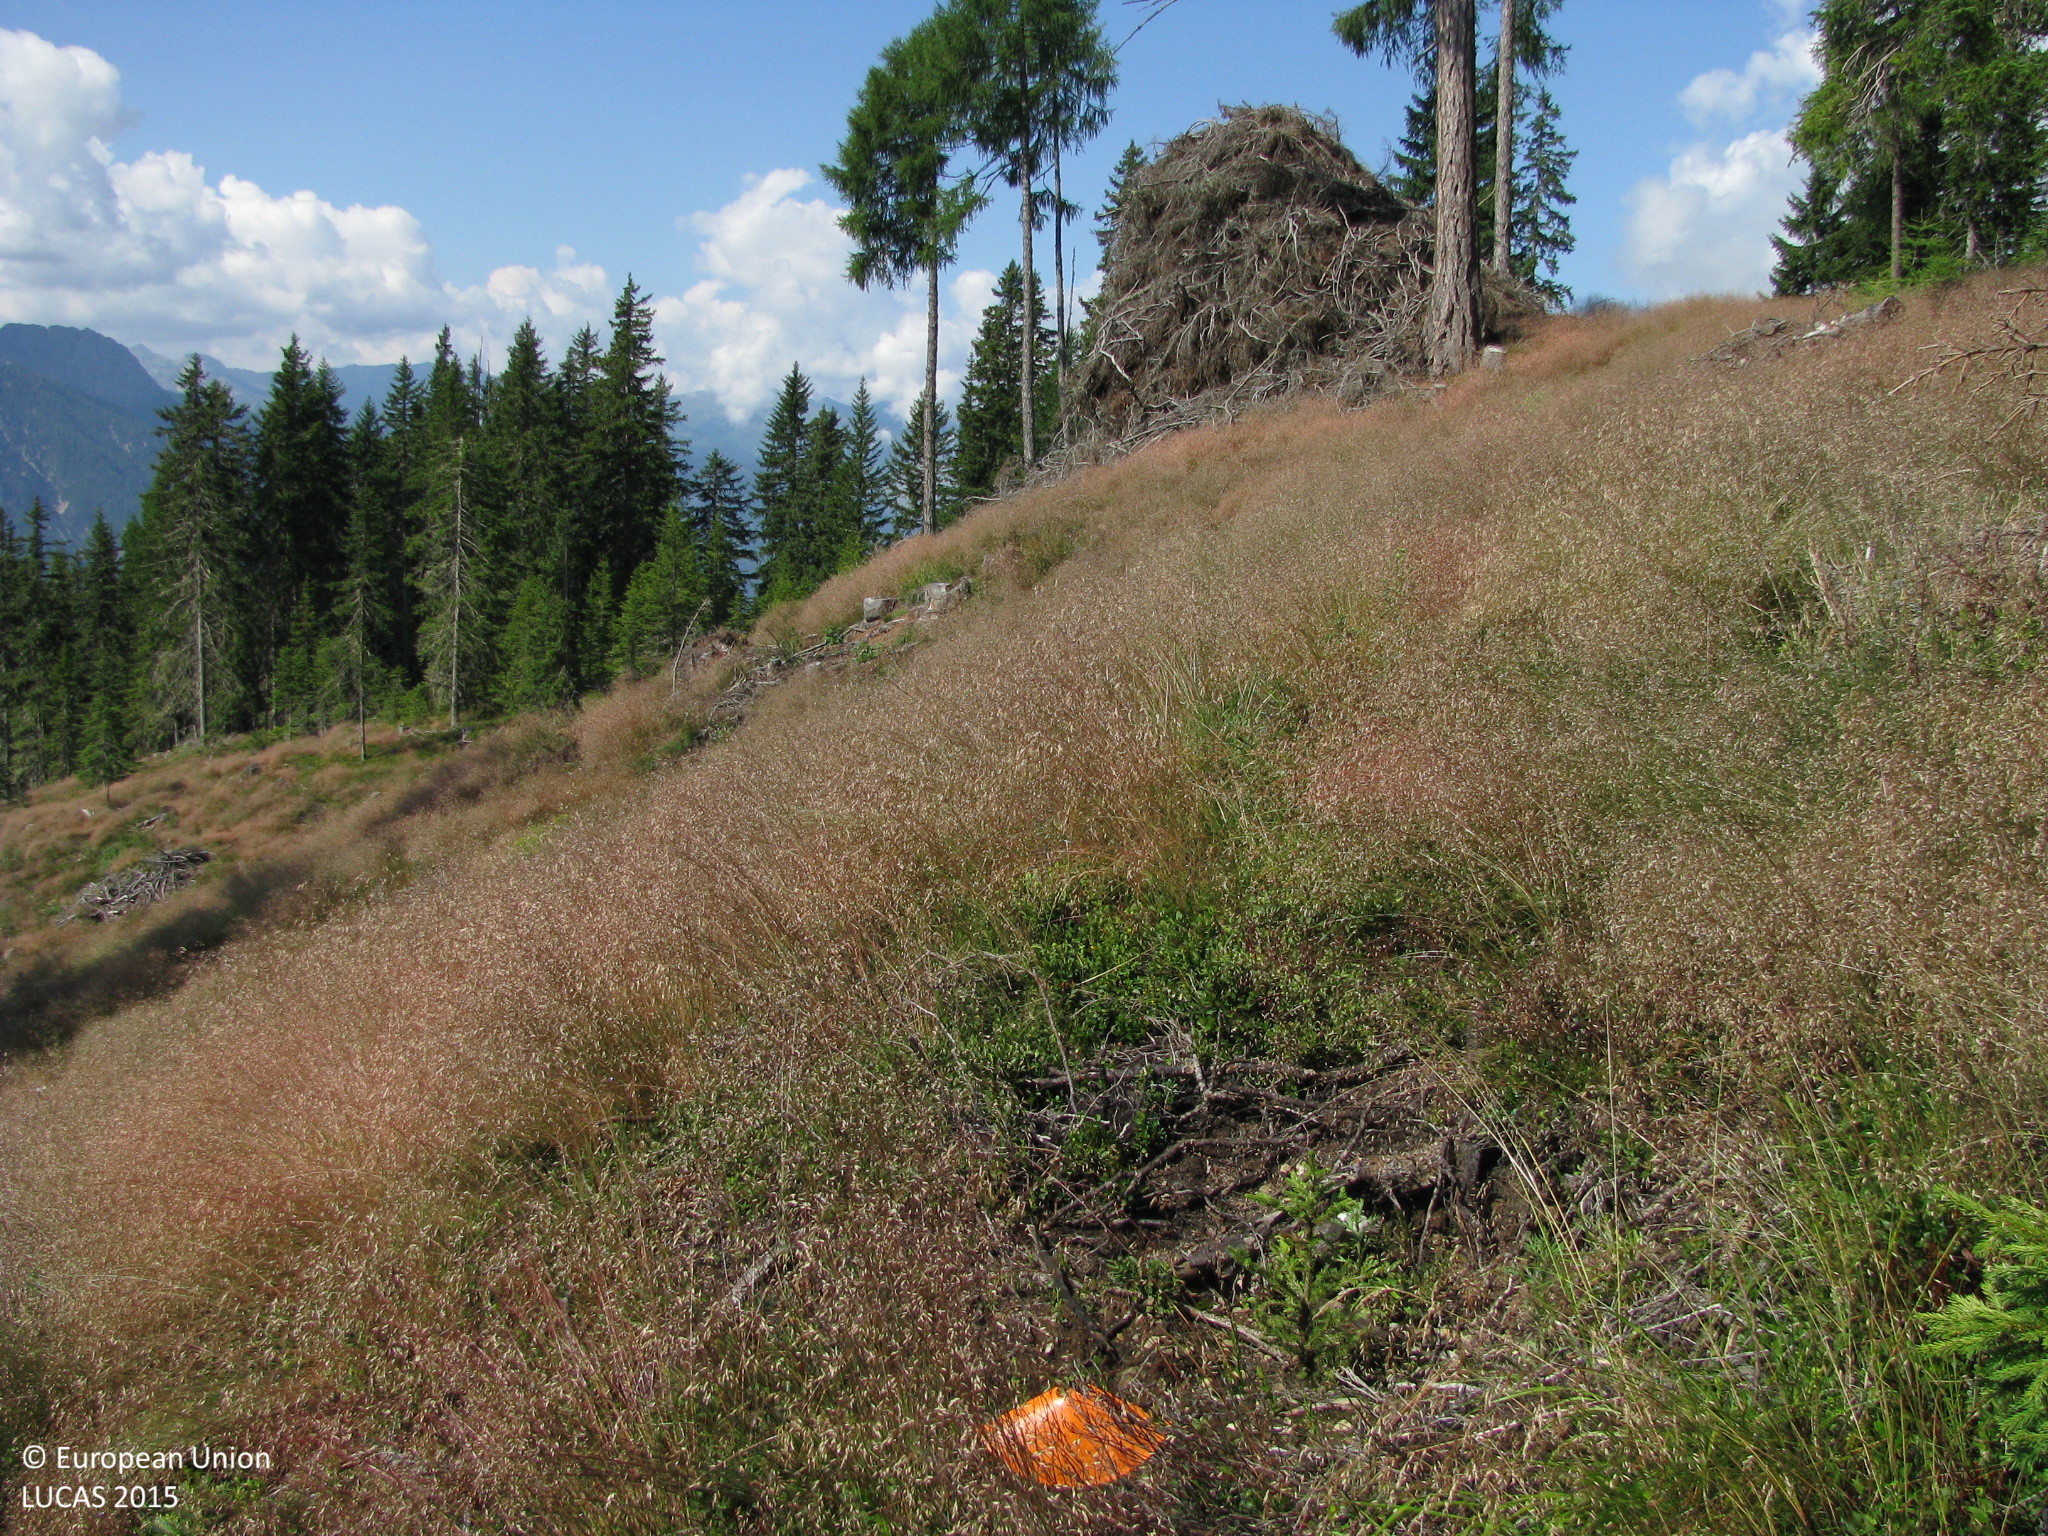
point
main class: Grassland
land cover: Grassland with sparse tree/shrub cover
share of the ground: > 75 %
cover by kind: herbaceous plants 90 %, coniferous forest trees 5 %, unconsolidated bare surface 5 %
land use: Forestry
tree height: > 5 m
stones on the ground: < 10 %
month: July
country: AT
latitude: 46.8047
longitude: 12.6576
